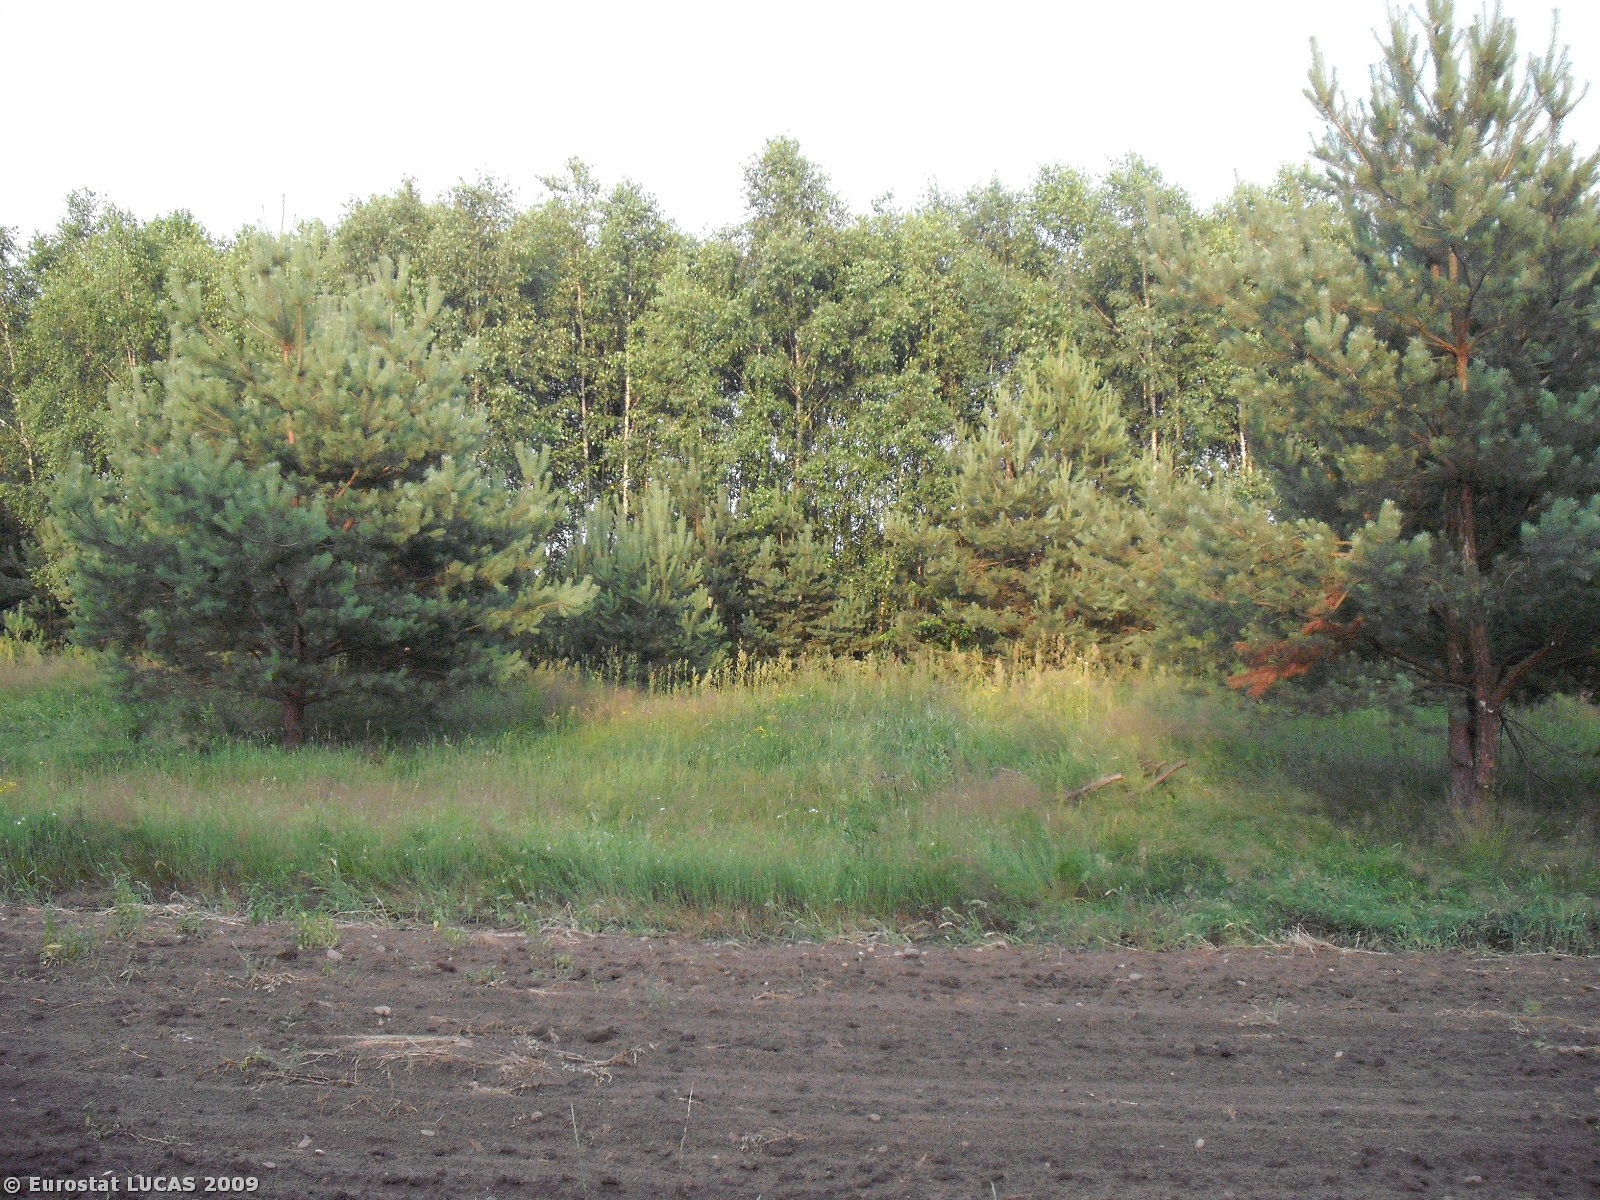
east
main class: Grassland
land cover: Grassland without tree/shrub cover
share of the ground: > 75 %
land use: Agriculture (excluding fallow land and kitchen gardens)
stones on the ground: < 10 %
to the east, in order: Grassland without tree/shrub cover; Tracks; Spontaneously vegetated surfaces; Coniferous woodland; Broadleaved woodland; Grassland without tree/shrub cover; Tracks; Mixed woodland; Grassland with sparse tree/shrub cover; Grassland without tree/shrub cover; Coniferous woodland; Electric lines; Coniferous woodland; Broadleaved woodland; Tracks; Fences; Artificial constructions in urban areas; Fences; Spontaneously vegetated surfaces
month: July
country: PL
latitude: 51.0475
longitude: 20.8116
